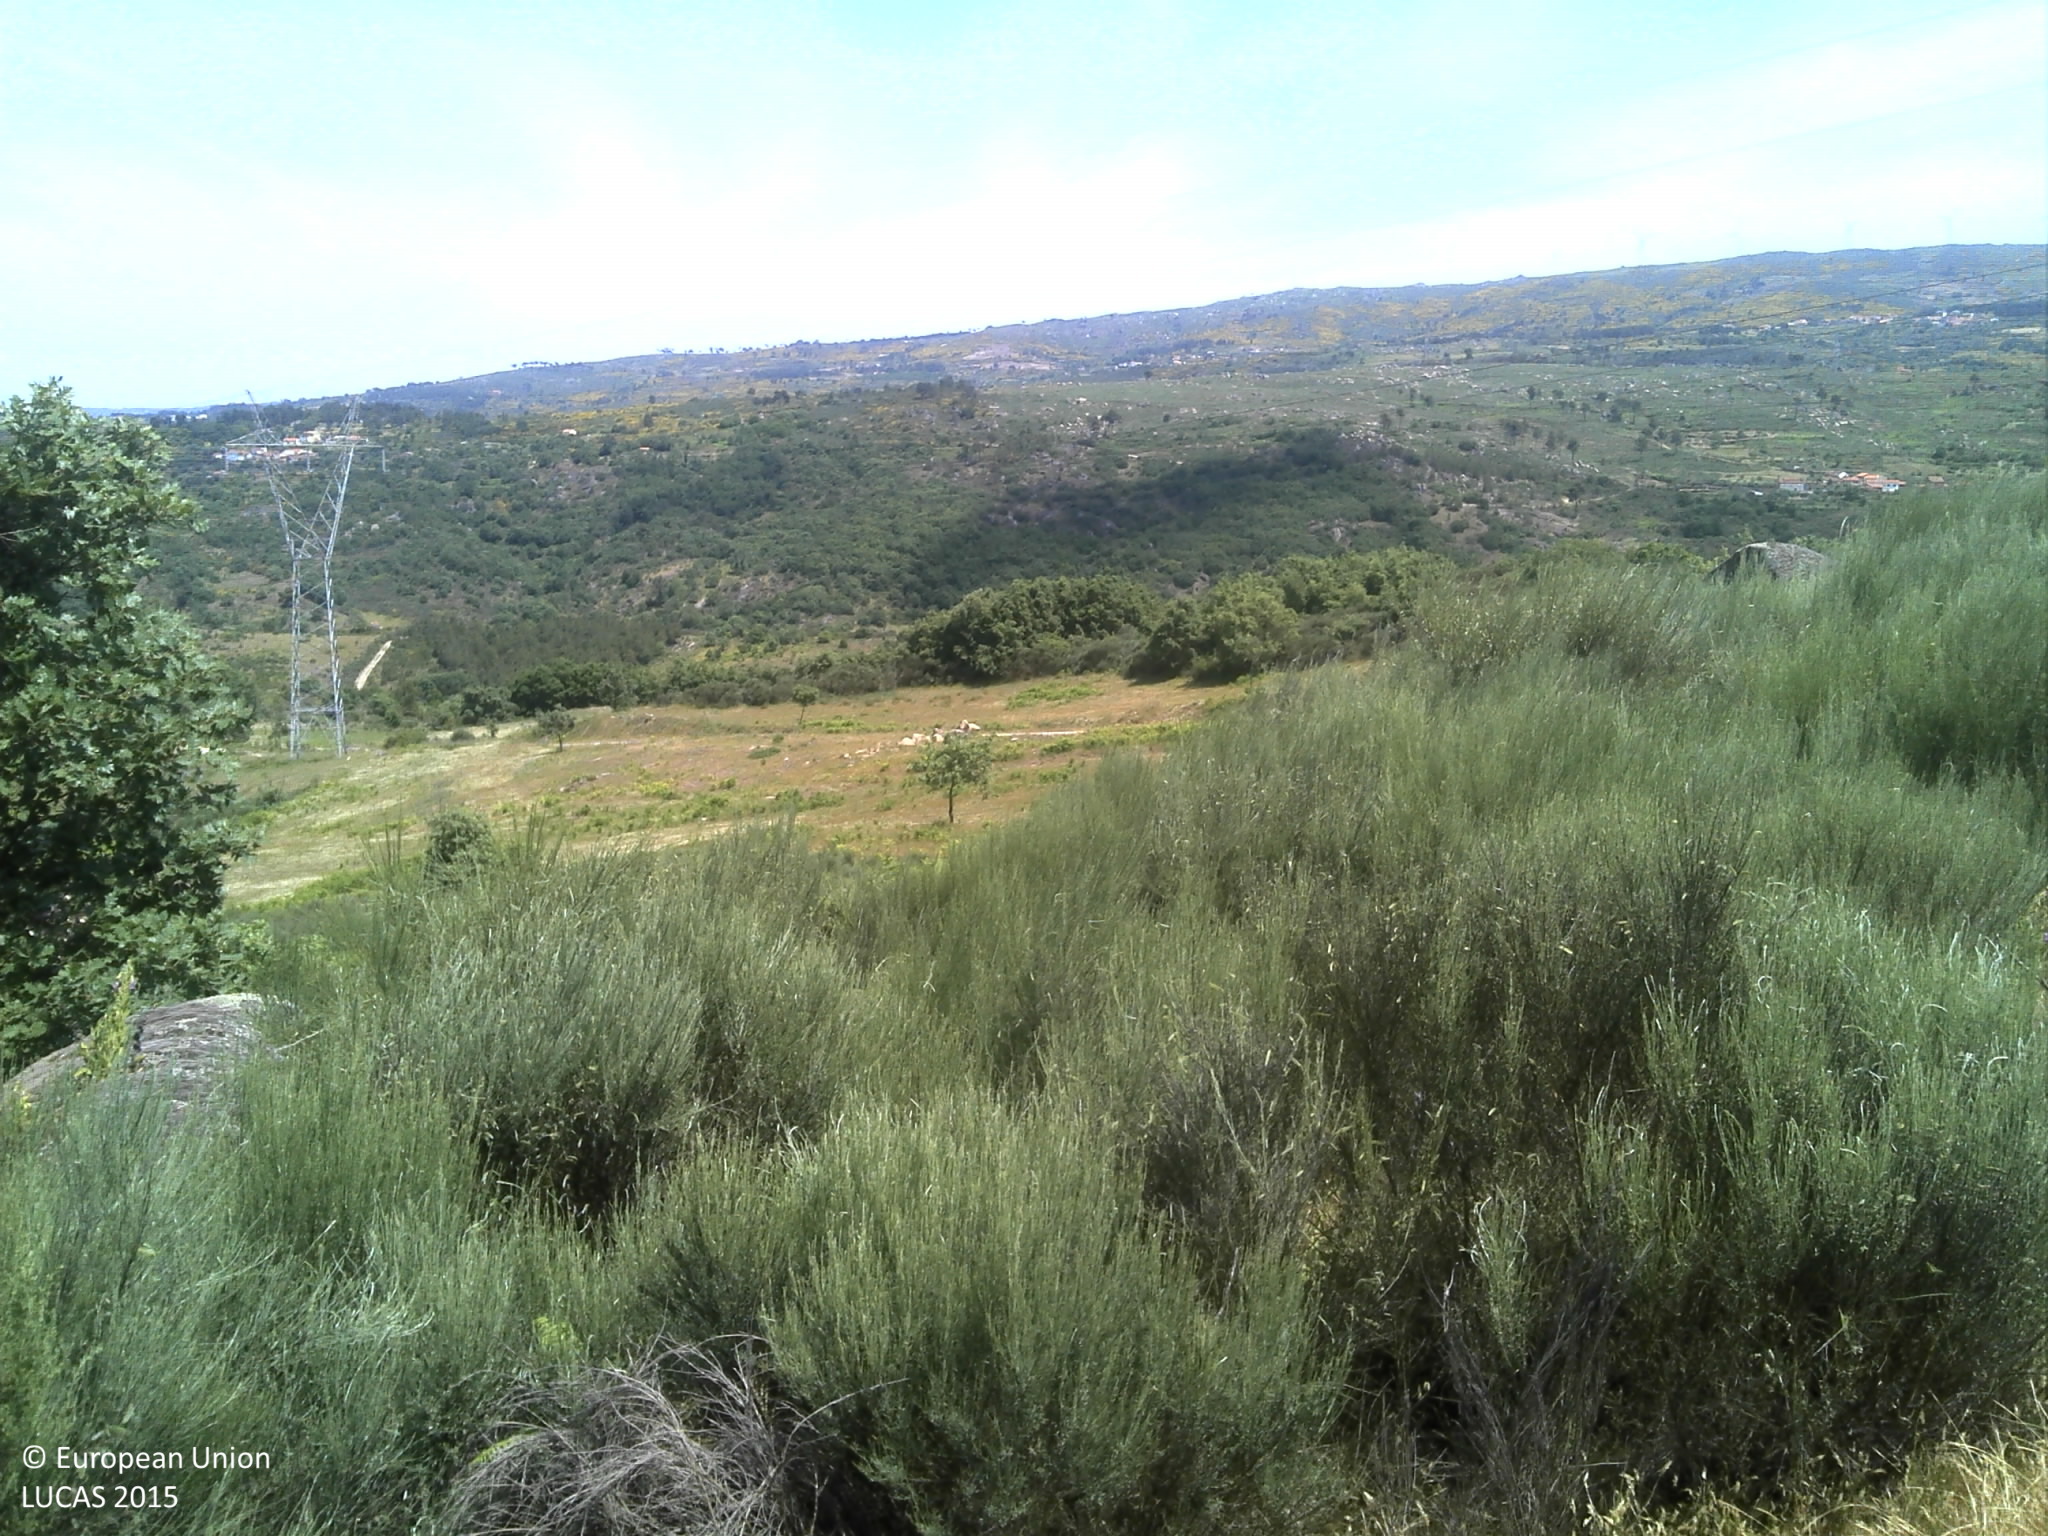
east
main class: Shrubland
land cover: Shrubland without tree cover
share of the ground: 50 - 75 %
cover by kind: shrubs 75 %, herbaceous plants 20 %, unconsolidated bare surface 5 %
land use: Semi-natural and natural areas not in use
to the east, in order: Shrubland without tree cover; Grassland without tree/shrub cover; Electric lines; Grassland without tree/shrub cover; Electric lines; Grass margins; Tracks; Grass margins; Grassland without tree/shrub cover
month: May
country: PT
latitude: 40.6090
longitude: -7.4499
